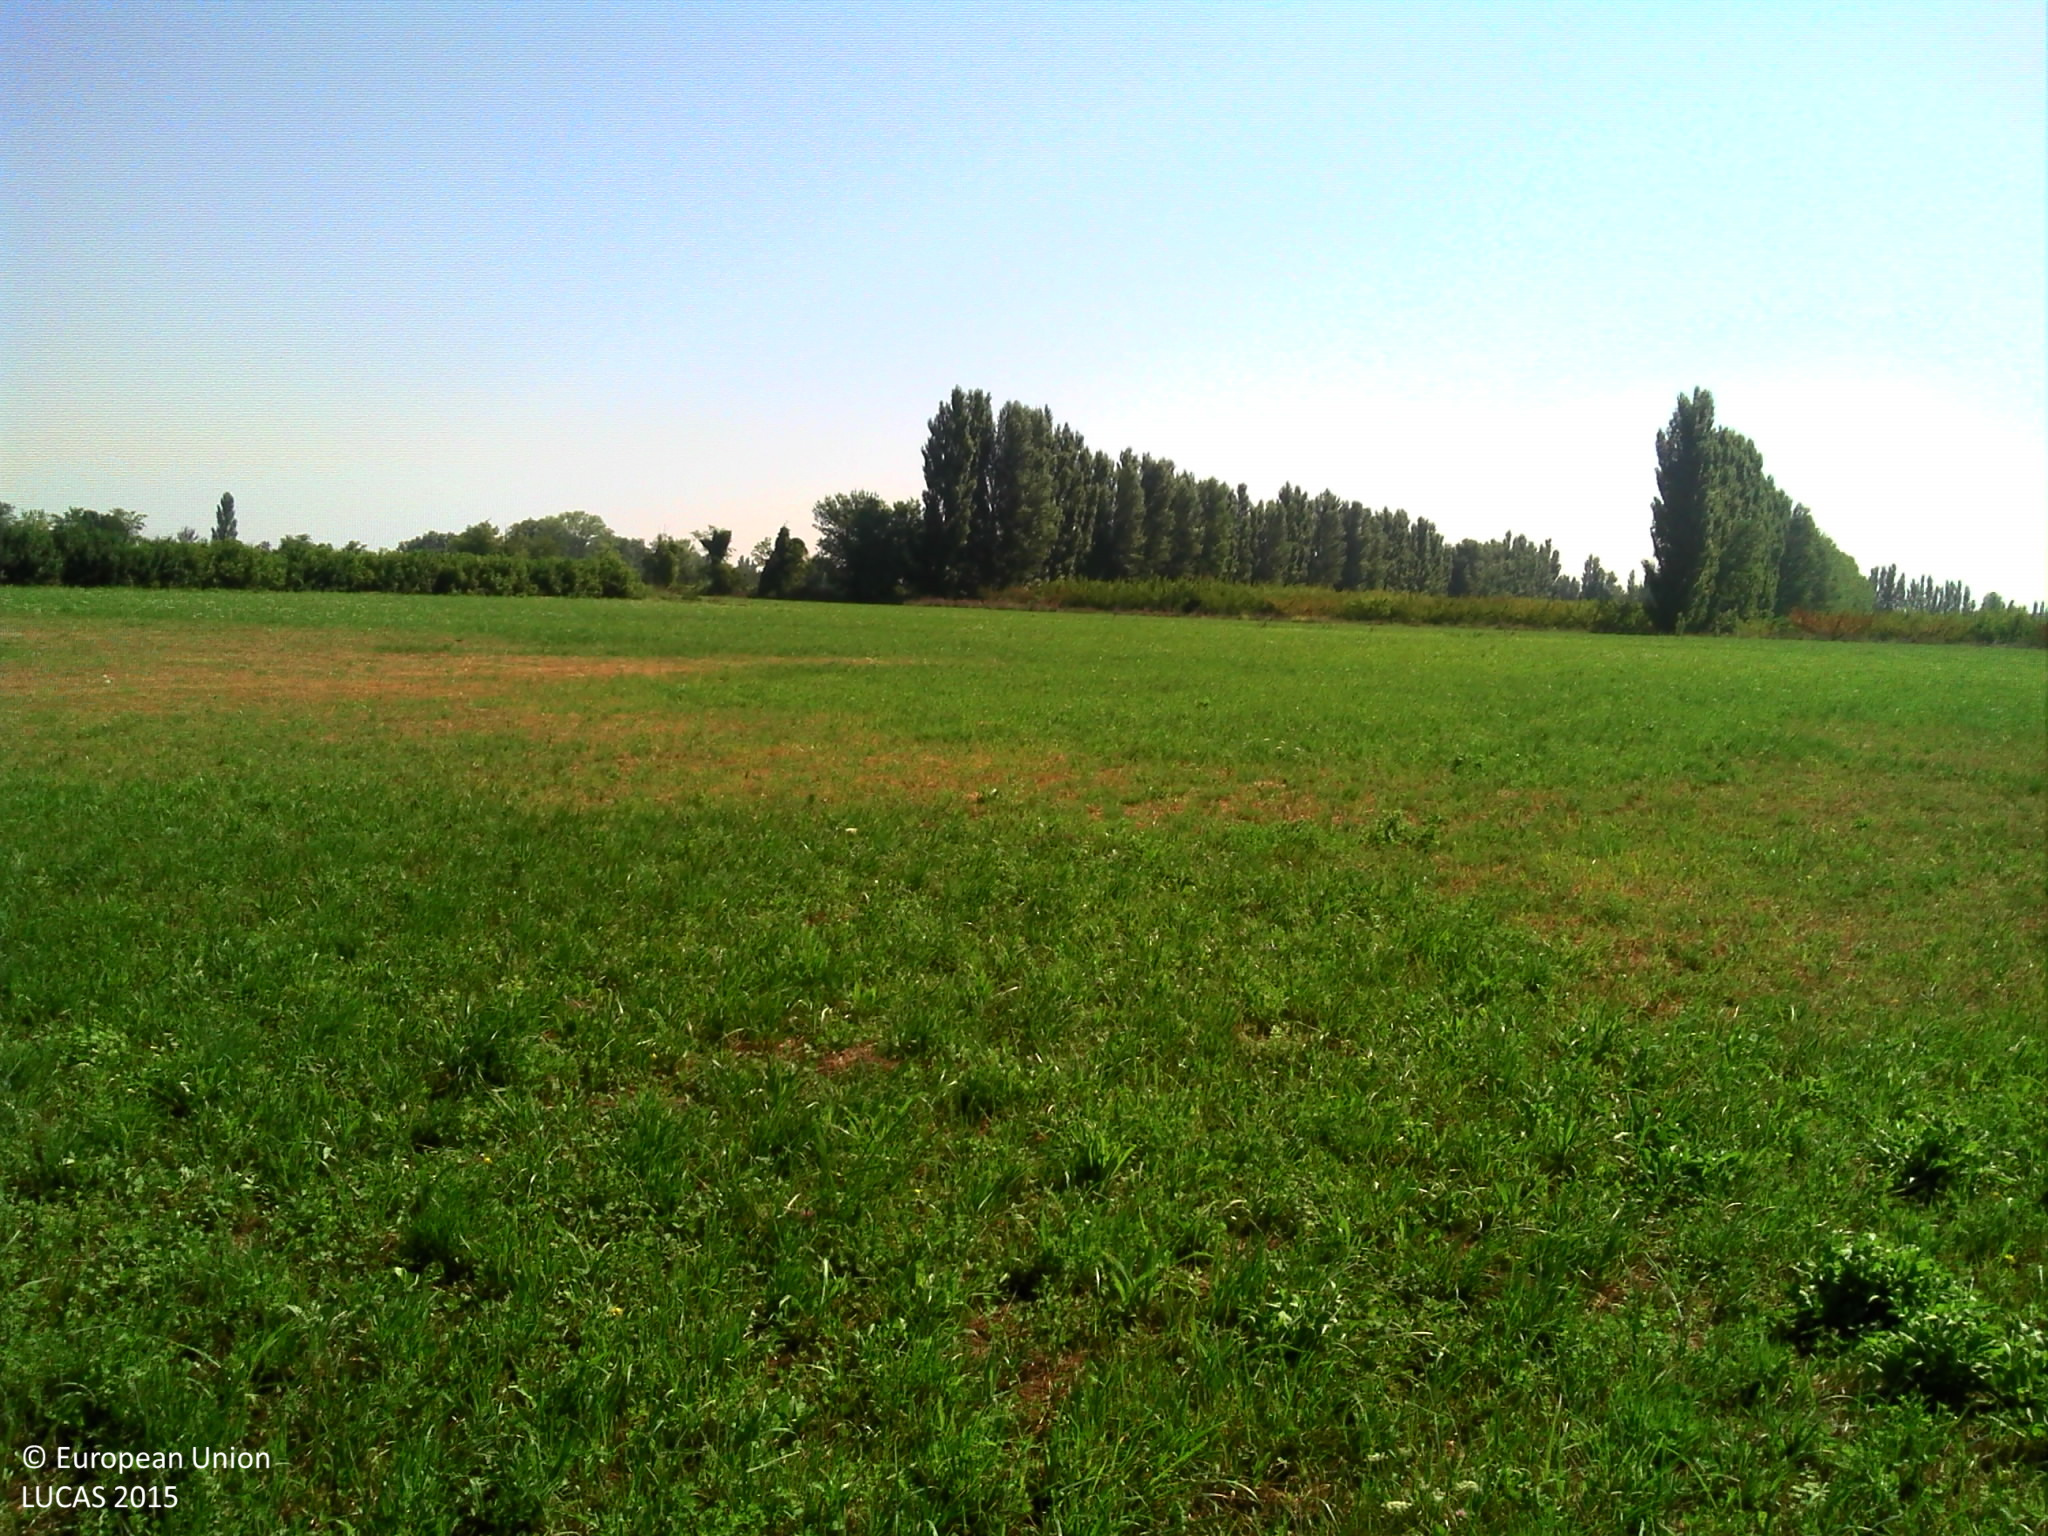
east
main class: Grassland
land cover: Grassland without tree/shrub cover
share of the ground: > 75 %
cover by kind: herbaceous plants 100 %
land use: Agriculture (excluding fallow land and kitchen gardens)
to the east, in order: Grassland without tree/shrub cover; Ditches and canals; Grassland without tree/shrub cover; Ditches and canals; Grass margins; Tracks; Other fruit trees and berries
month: July
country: FR
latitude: 43.5848
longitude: 4.7462
